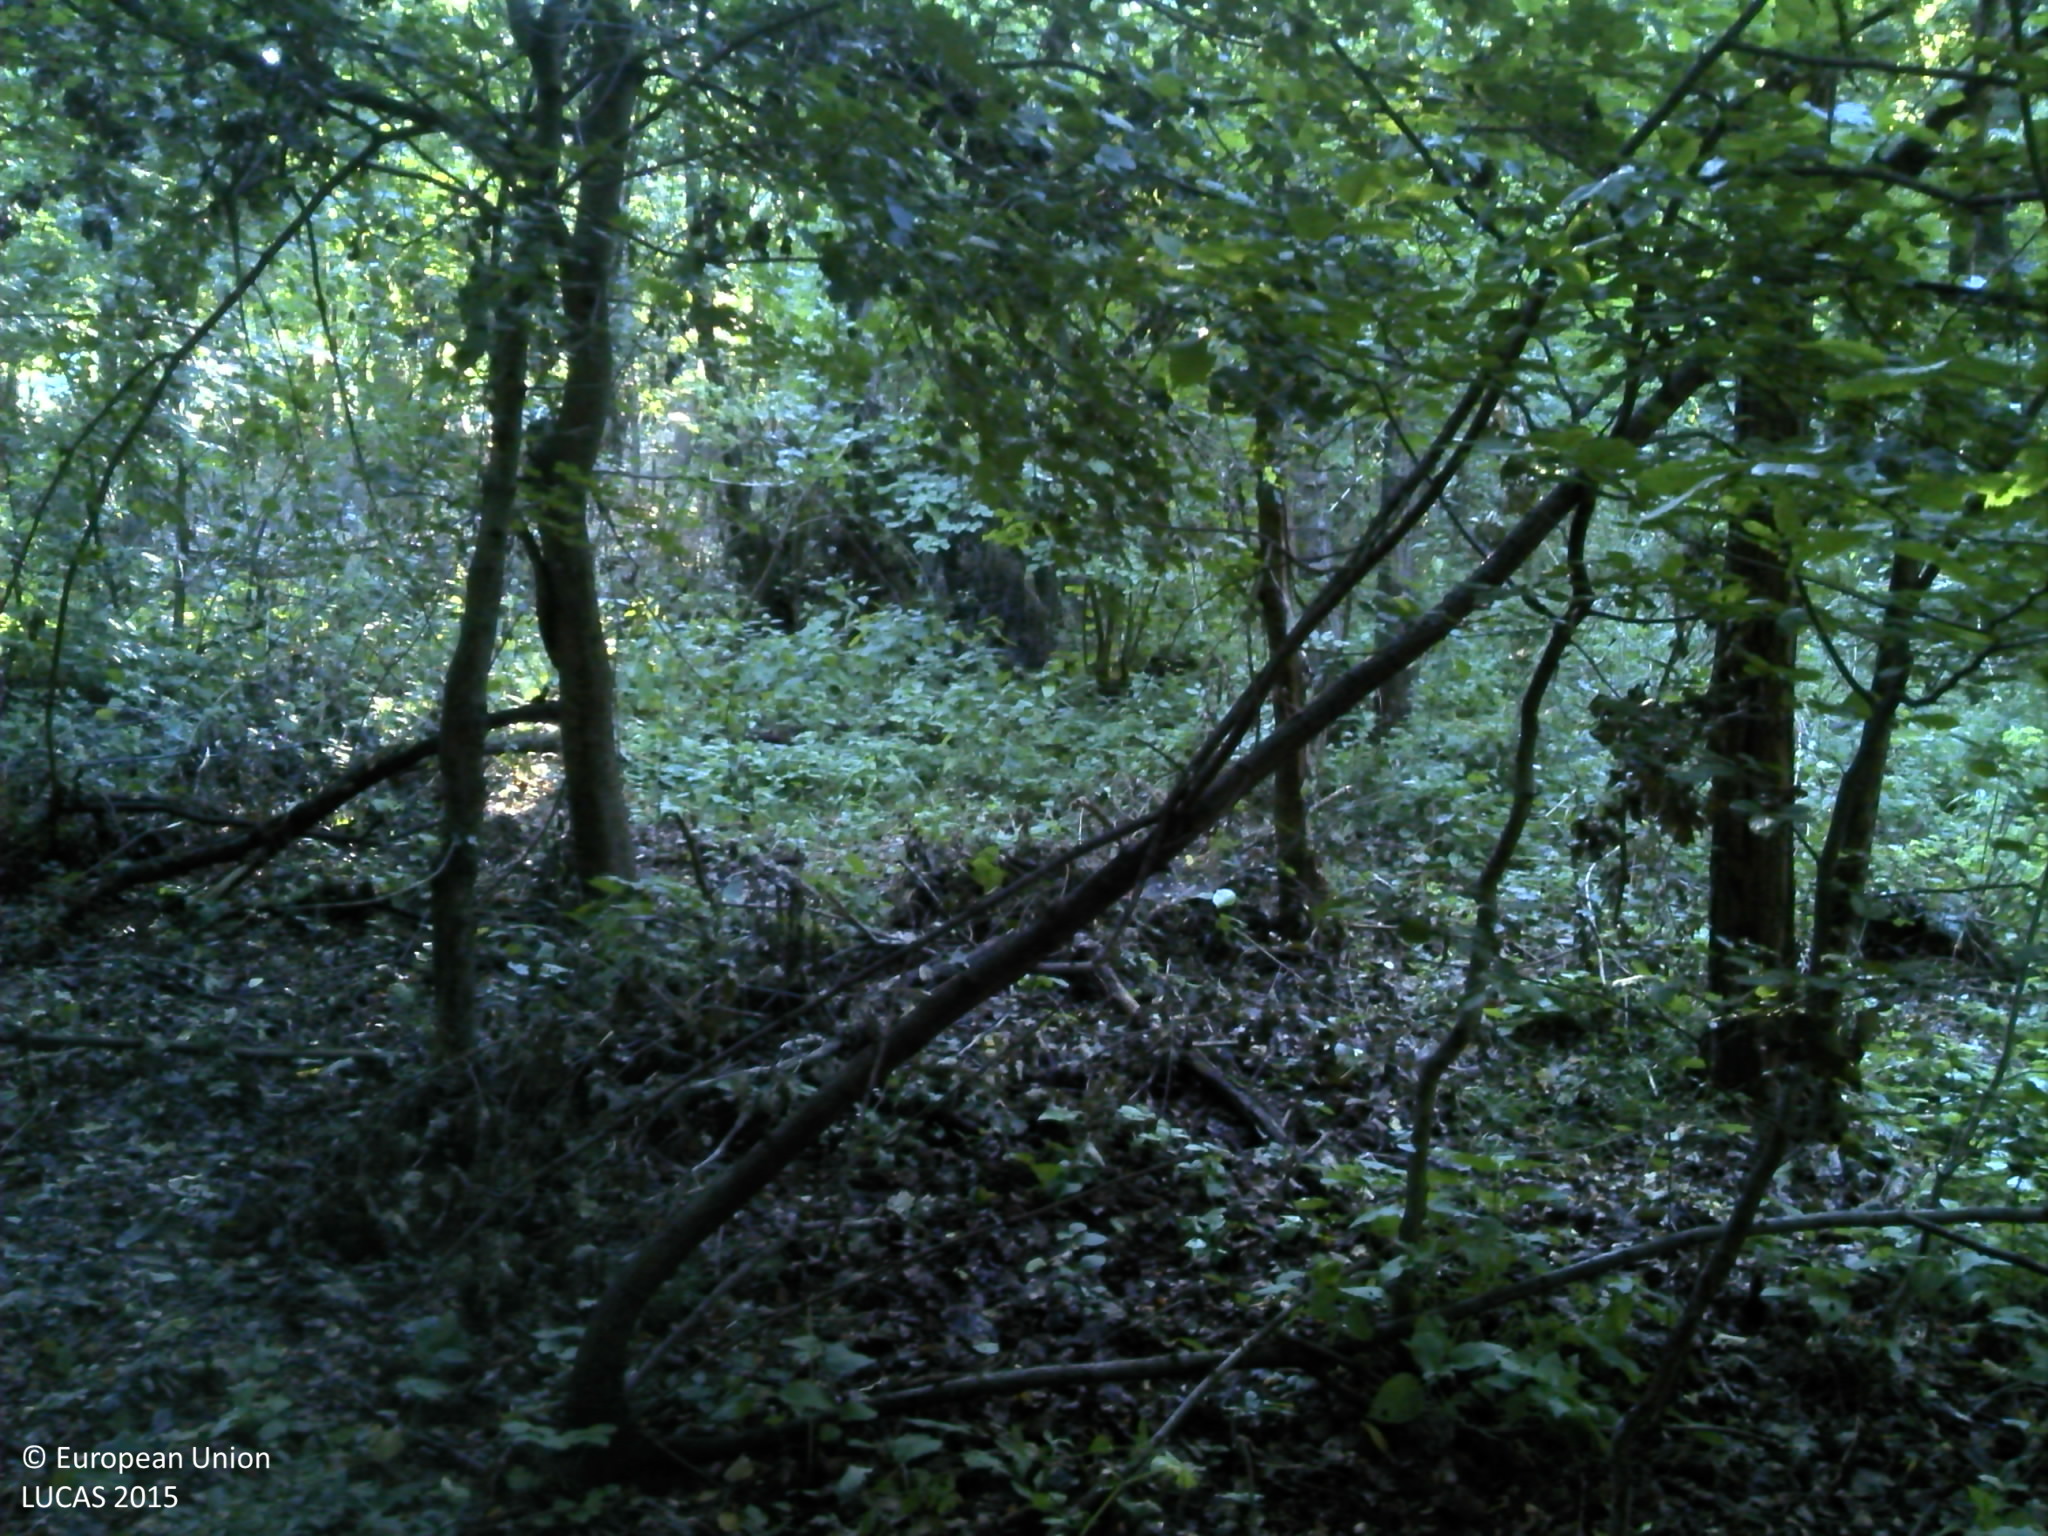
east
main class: Woodland
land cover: Broadleaved woodland
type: acidophilous oak and oak-birch forest
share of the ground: > 75 %
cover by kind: broadleaved forest trees 90 %, shrubs 5 %, herbaceous plants 5 %
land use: Forestry
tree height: > 5 m
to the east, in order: Broadleaved woodland
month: July
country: HR
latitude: 45.9915
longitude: 16.7785
